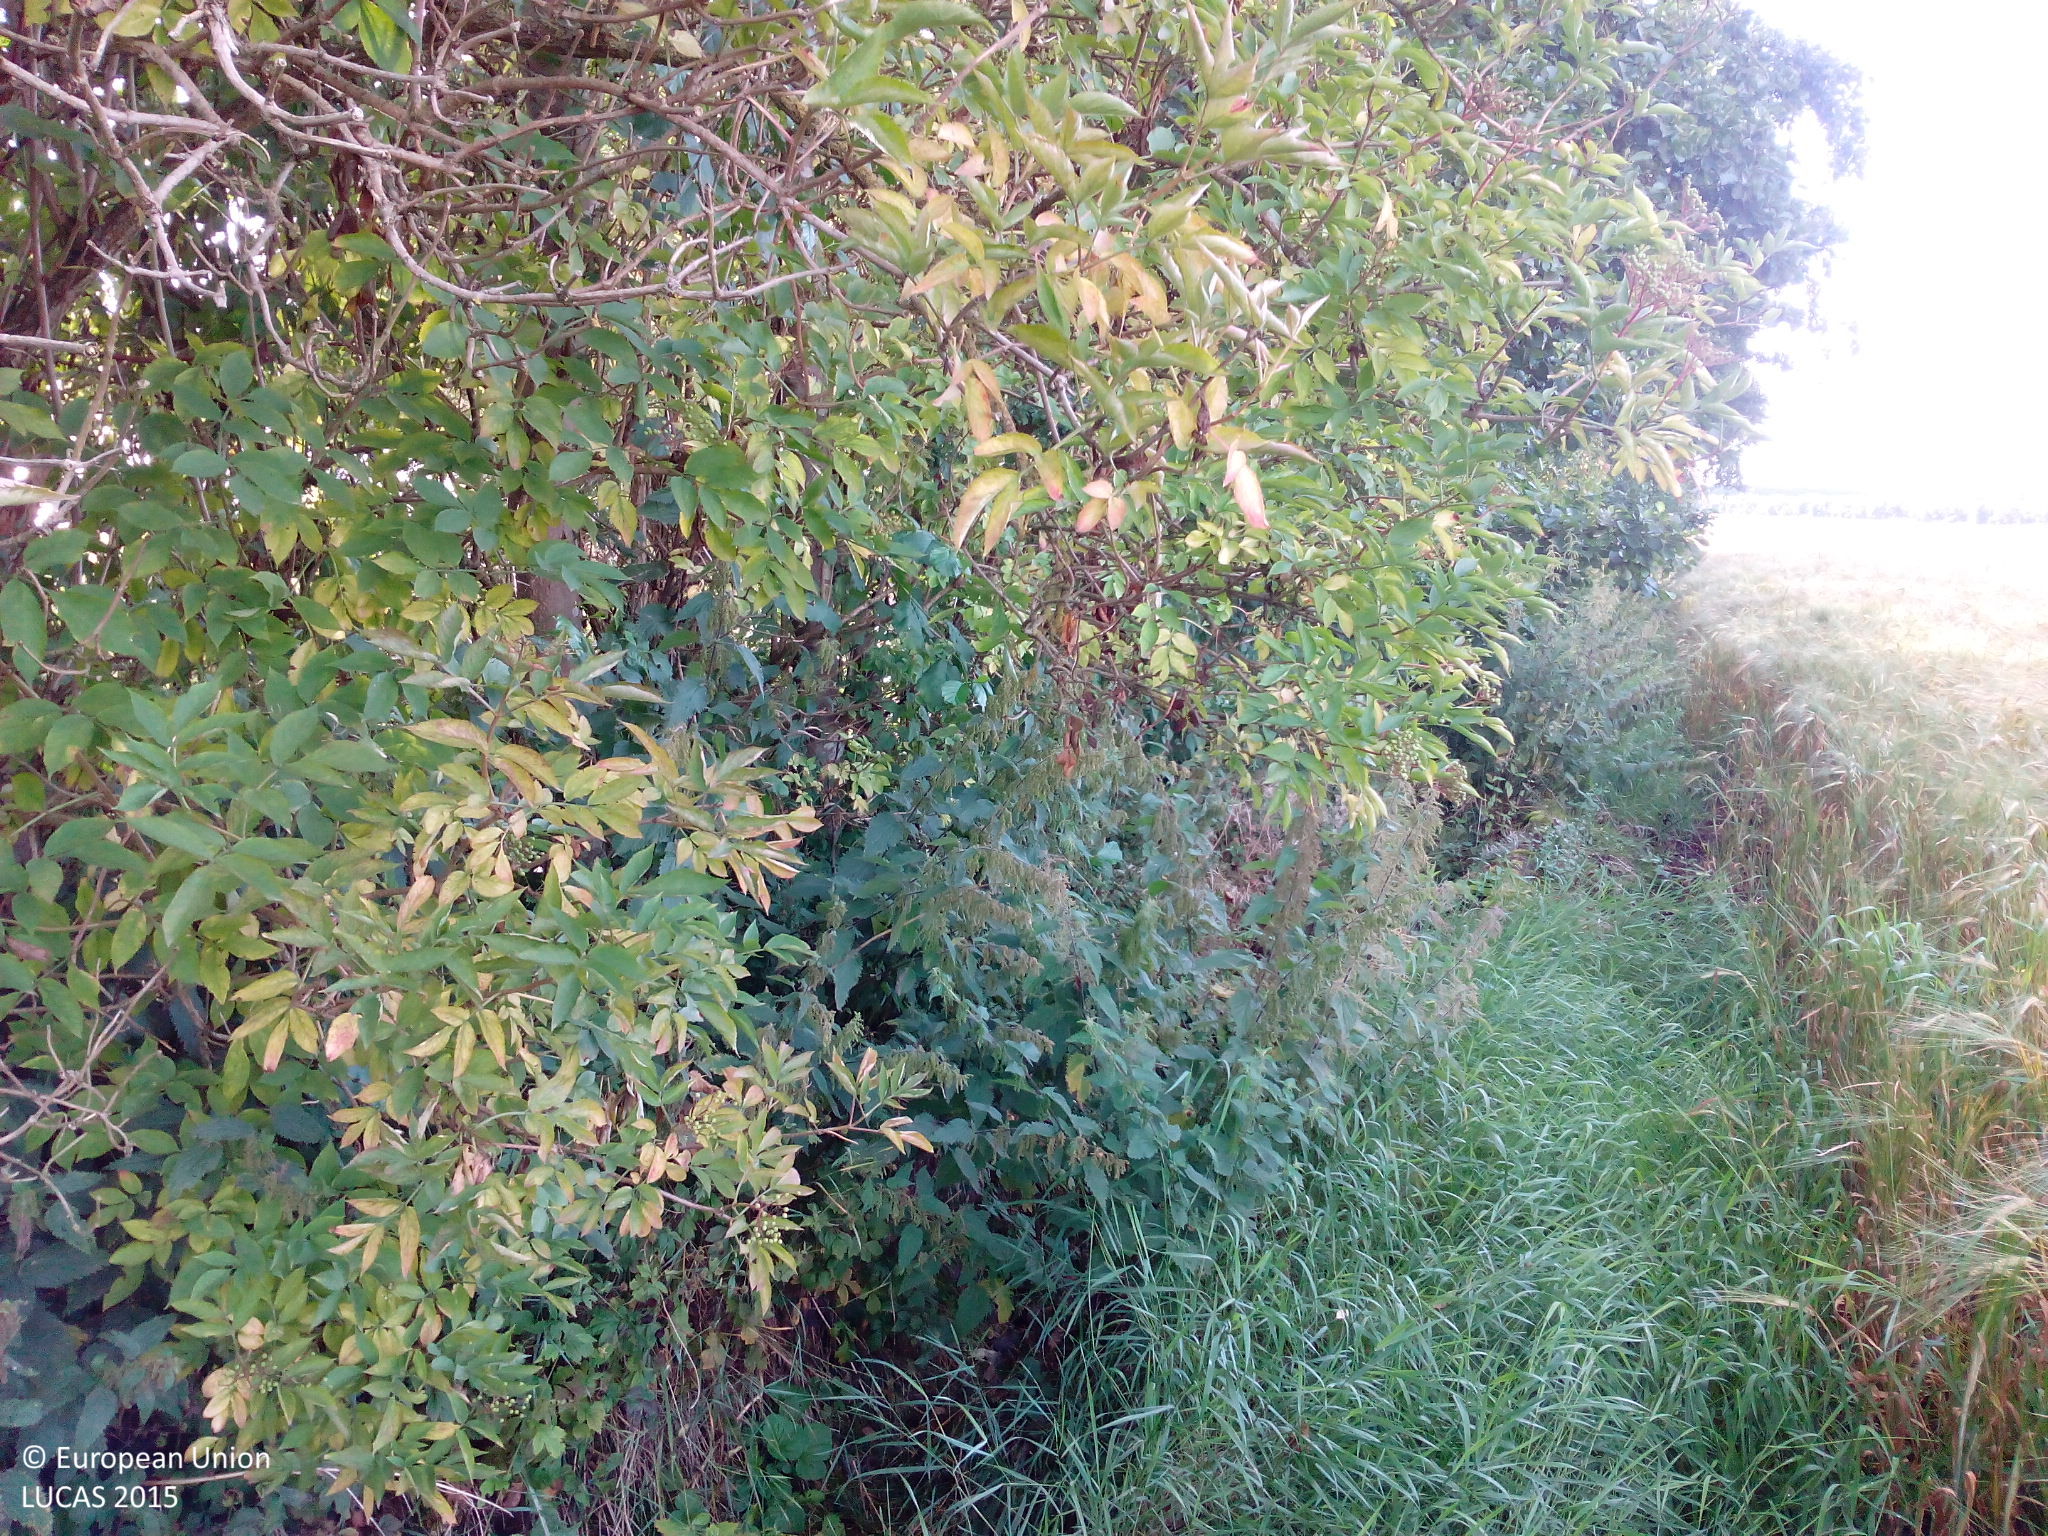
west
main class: Cropland
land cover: Barley
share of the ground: > 75 %
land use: Agriculture (excluding fallow land and kitchen gardens)
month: August
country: DK
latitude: 55.5956
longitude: 12.0771
